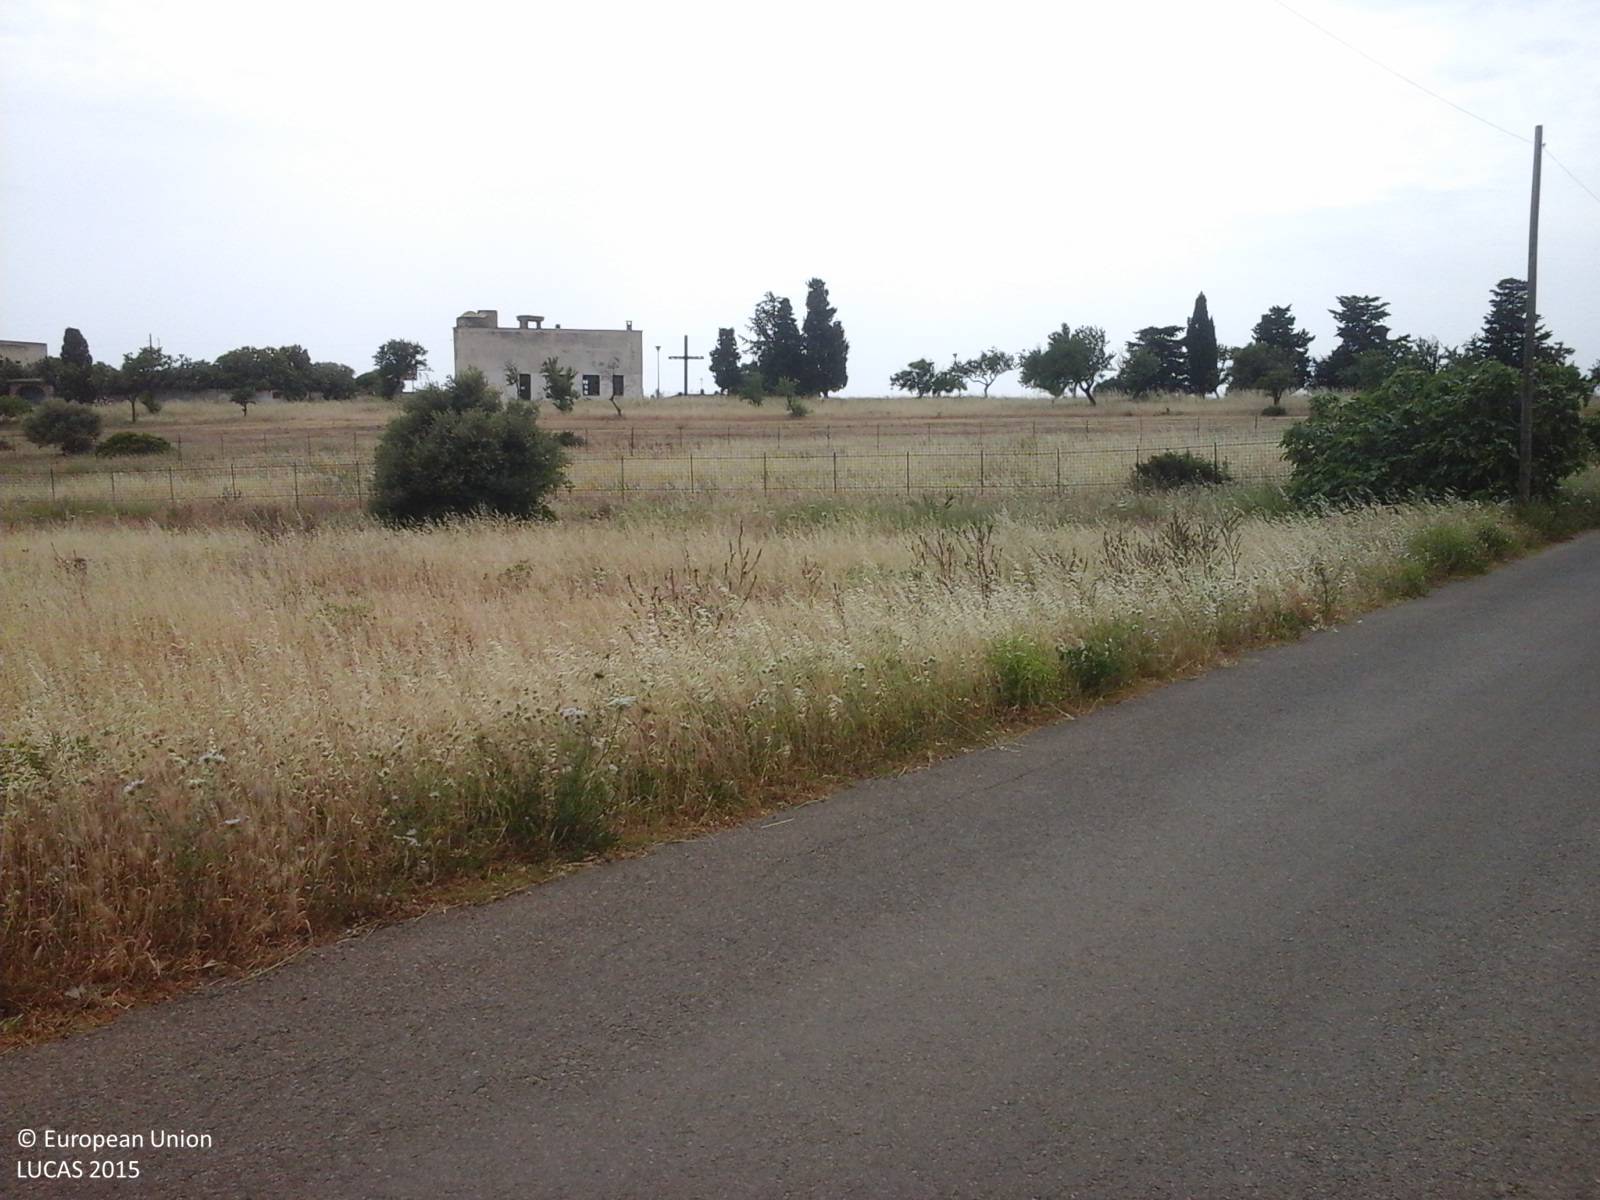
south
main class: Cropland
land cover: Mixed cereals for fodder
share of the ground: > 75 %
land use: Agriculture (excluding fallow land and kitchen gardens)
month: May
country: IT
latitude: 39.2319
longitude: 9.2286
